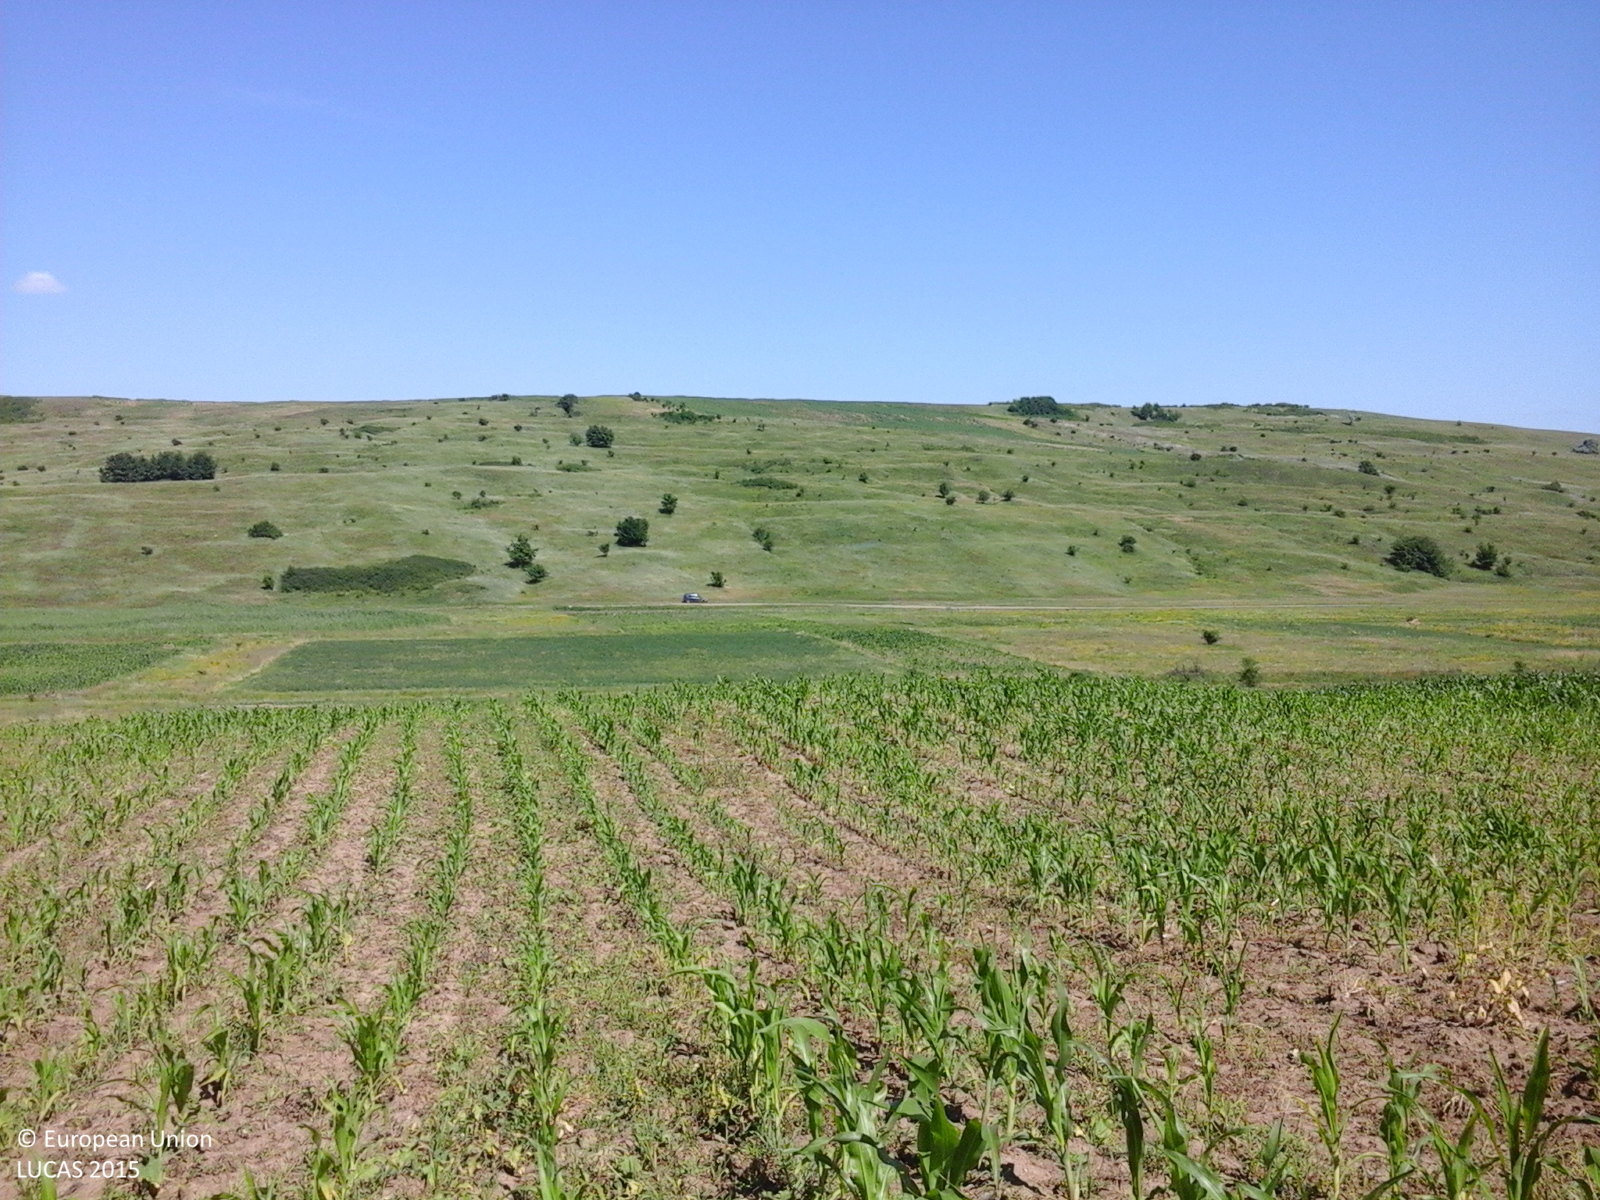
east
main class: Cropland
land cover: Maize
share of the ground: 25 - 50 %
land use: Agriculture (excluding fallow land and kitchen gardens)
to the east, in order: Maize; Grass margins; Tracks; Grass margins; Ditches and canals; Lucerne; Grassland without tree/shrub cover; Maize
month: June
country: RO
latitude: 47.1320
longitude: 27.0970
